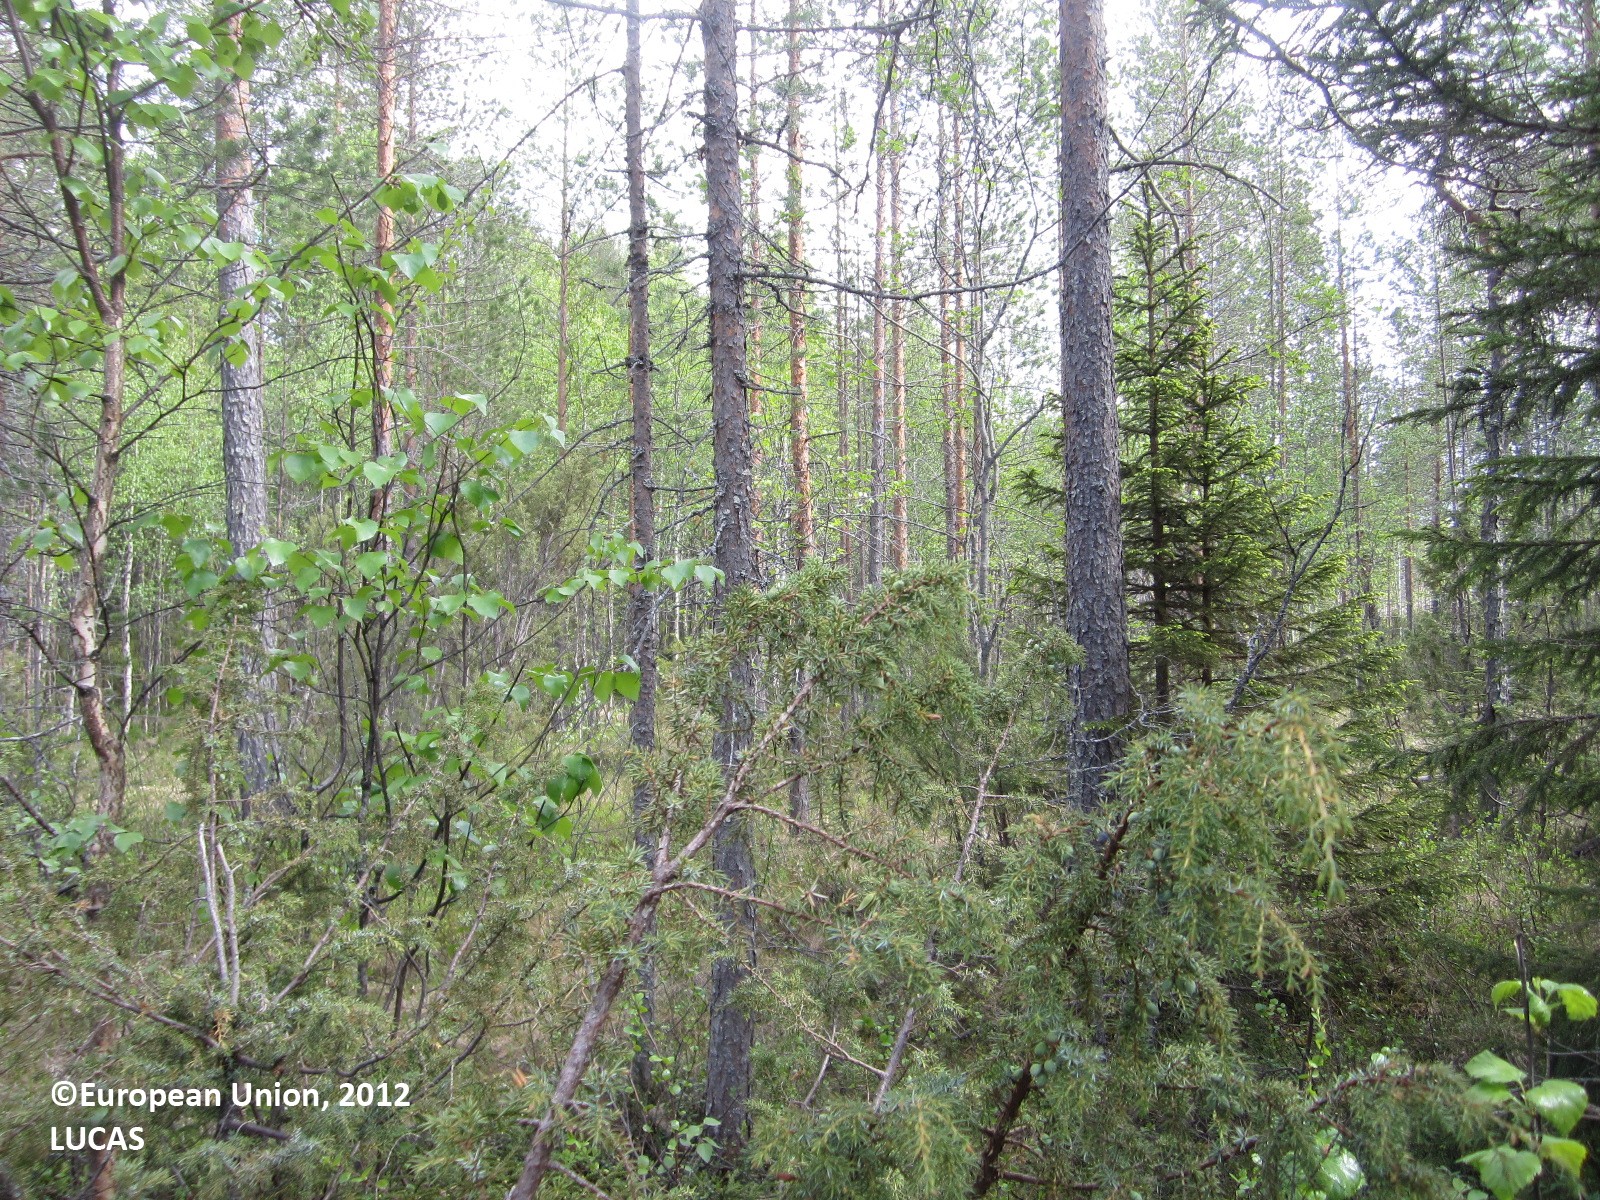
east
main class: Woodland
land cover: Other coniferous woodland
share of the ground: 50 - 75 %
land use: Forestry
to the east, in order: Other coniferous woodland; Pine dominated mixed woodland; Broadleaved woodland; Ditches and canals; Broadleaved woodland; Other coniferous woodland; Ditches and canals; Other coniferous woodland; Ditches and canals; Pine dominated coniferous woodland; Ditches and canals; Pine dominated coniferous woodland; Ditches and canals; Pine dominated coniferous woodland; Other coniferous woodland
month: June
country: FI
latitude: 64.5903
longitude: 28.7527
